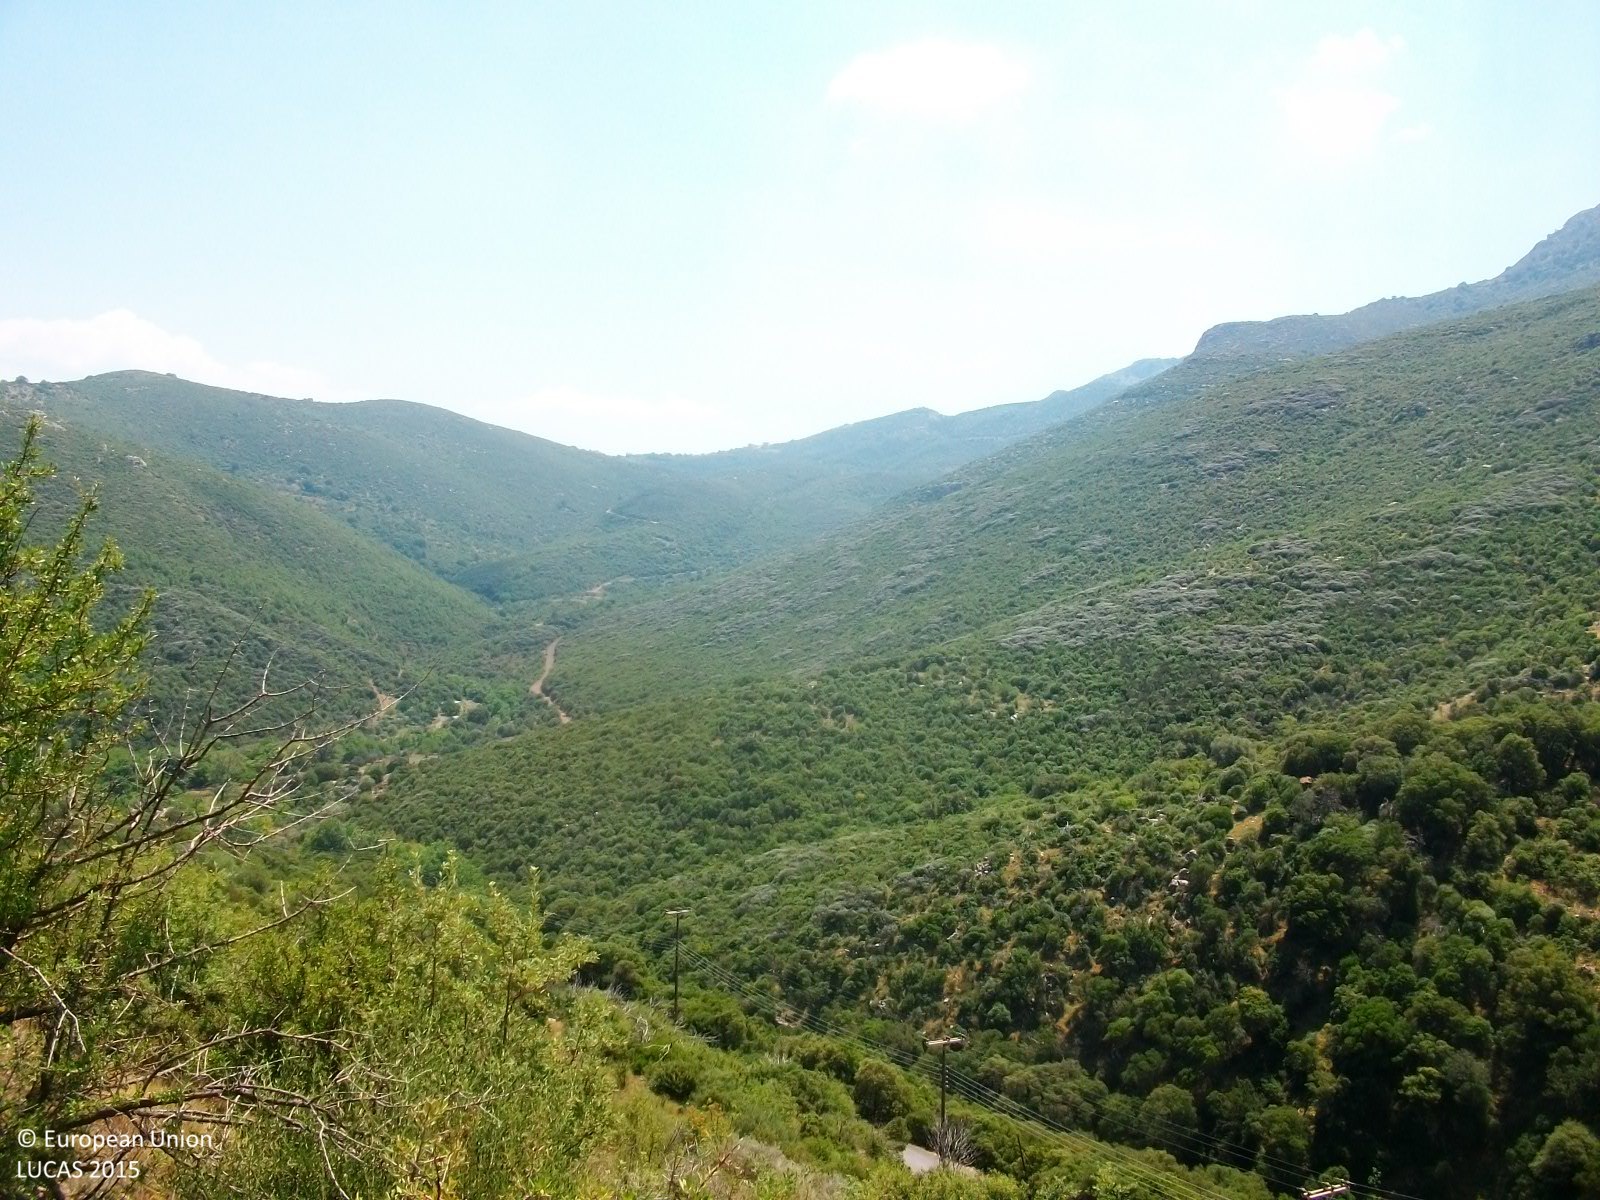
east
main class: Shrubland
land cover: Shrubland without tree cover
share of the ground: > 75 %
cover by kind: shrubs 100 %
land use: Semi-natural and natural areas not in use
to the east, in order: Shrubland without tree cover
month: July
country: GR
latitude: 37.4845
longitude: 21.9579
